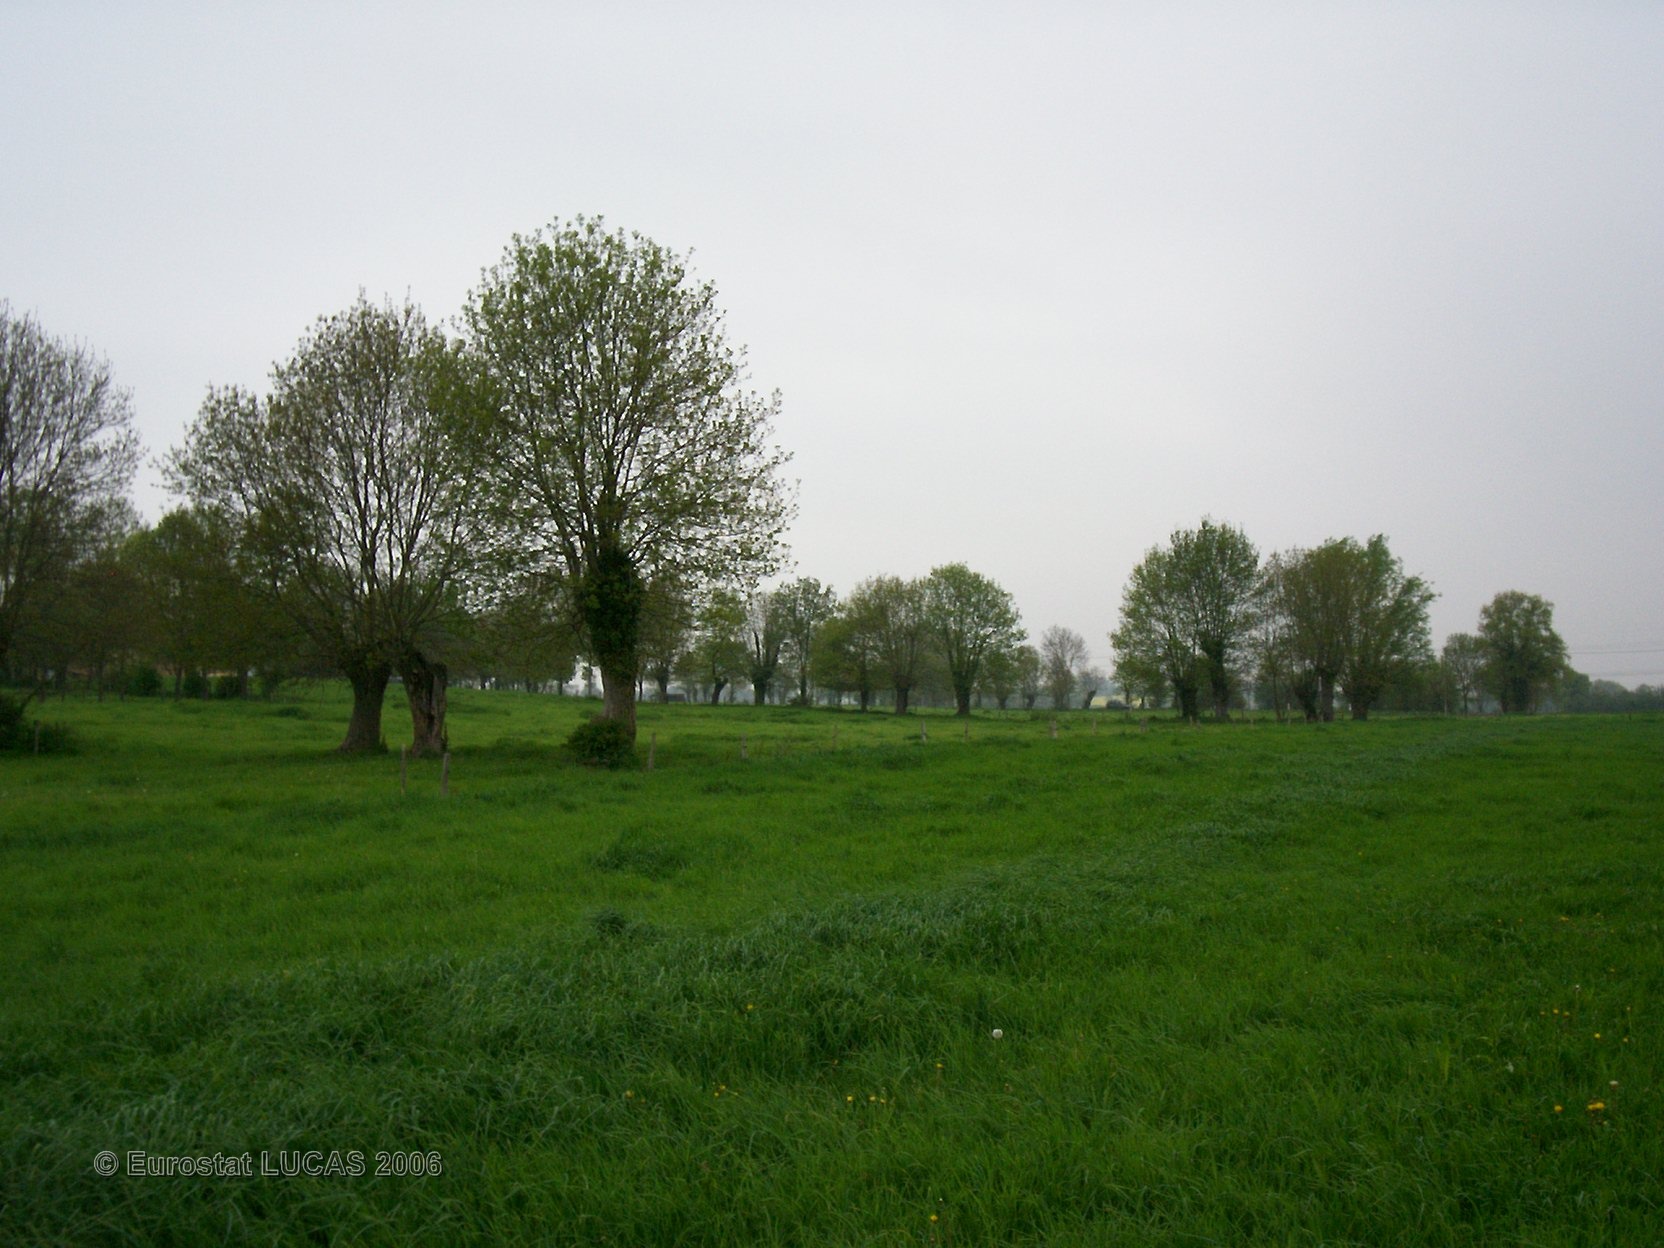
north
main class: Grassland
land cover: Grassland without tree/shrub cover
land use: Agriculture (excluding fallow land and kitchen gardens)
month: April
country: FR
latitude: 46.0837
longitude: 4.8689
